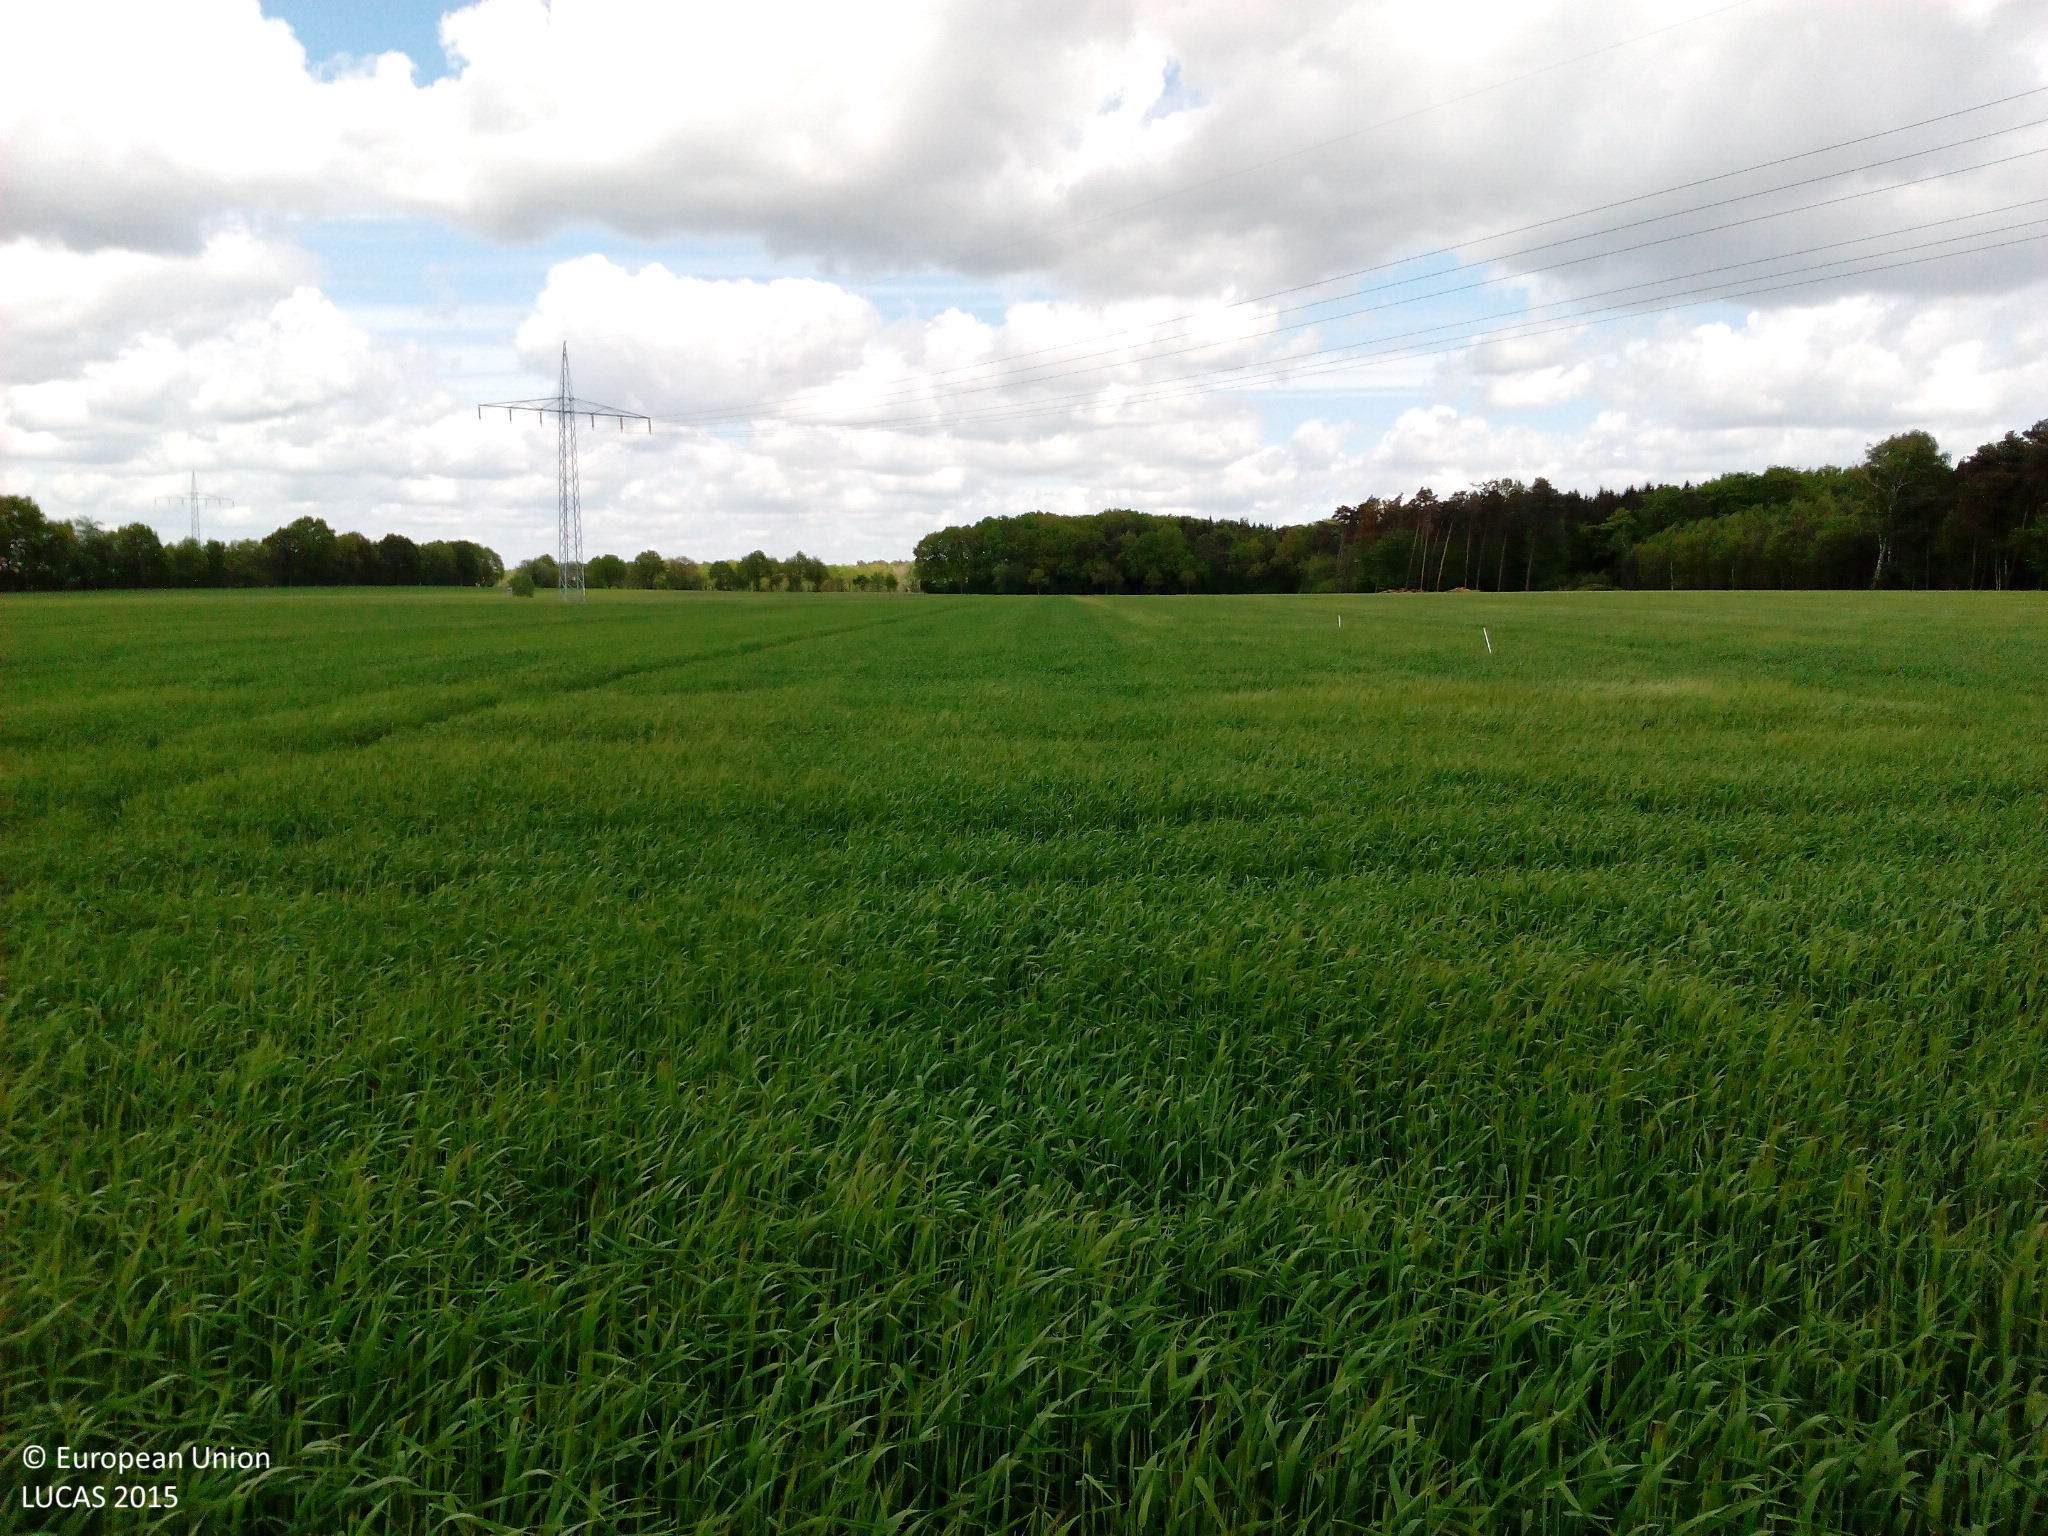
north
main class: Cropland
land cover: Barley
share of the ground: > 75 %
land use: Agriculture (excluding fallow land and kitchen gardens)
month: May
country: DE
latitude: 53.3454
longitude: 9.2043
